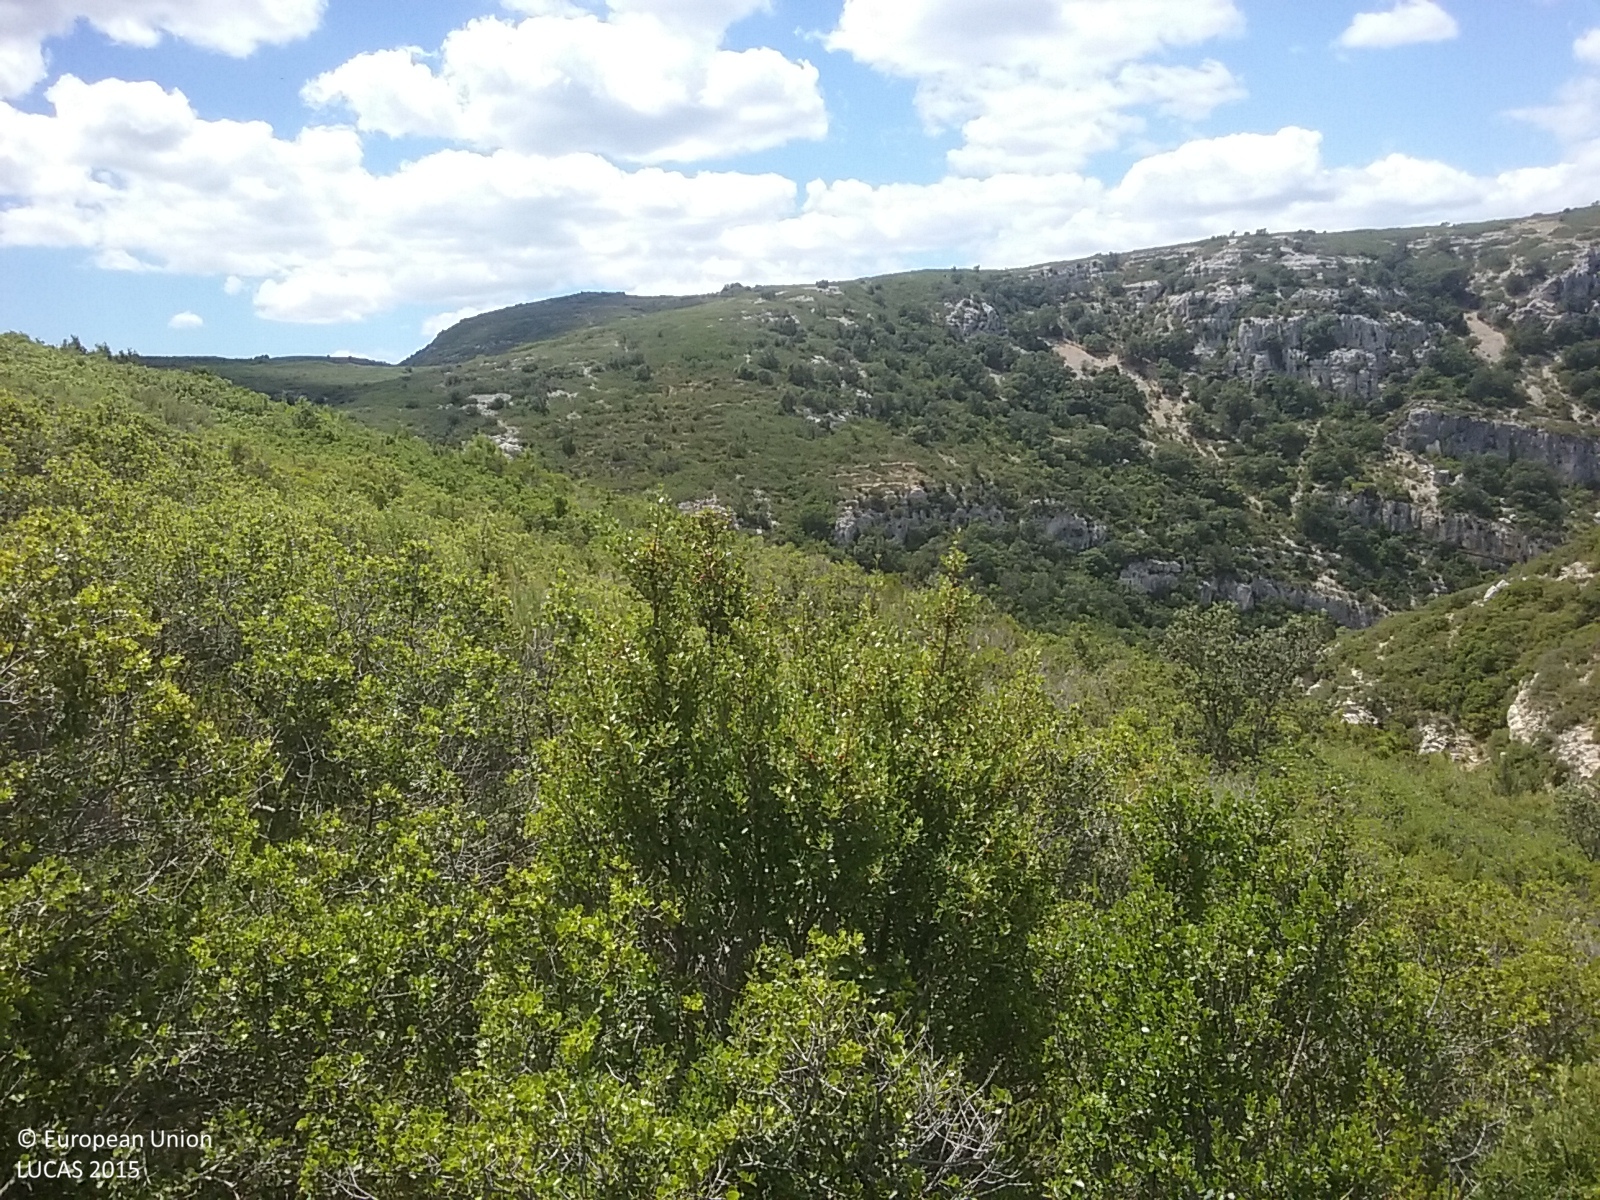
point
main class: Shrubland
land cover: Shrubland without tree cover
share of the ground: > 75 %
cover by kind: shrubs 95 %, herbaceous plants 5 %
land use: Semi-natural and natural areas not in use
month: May
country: ES
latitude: 40.3836
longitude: 0.0893
